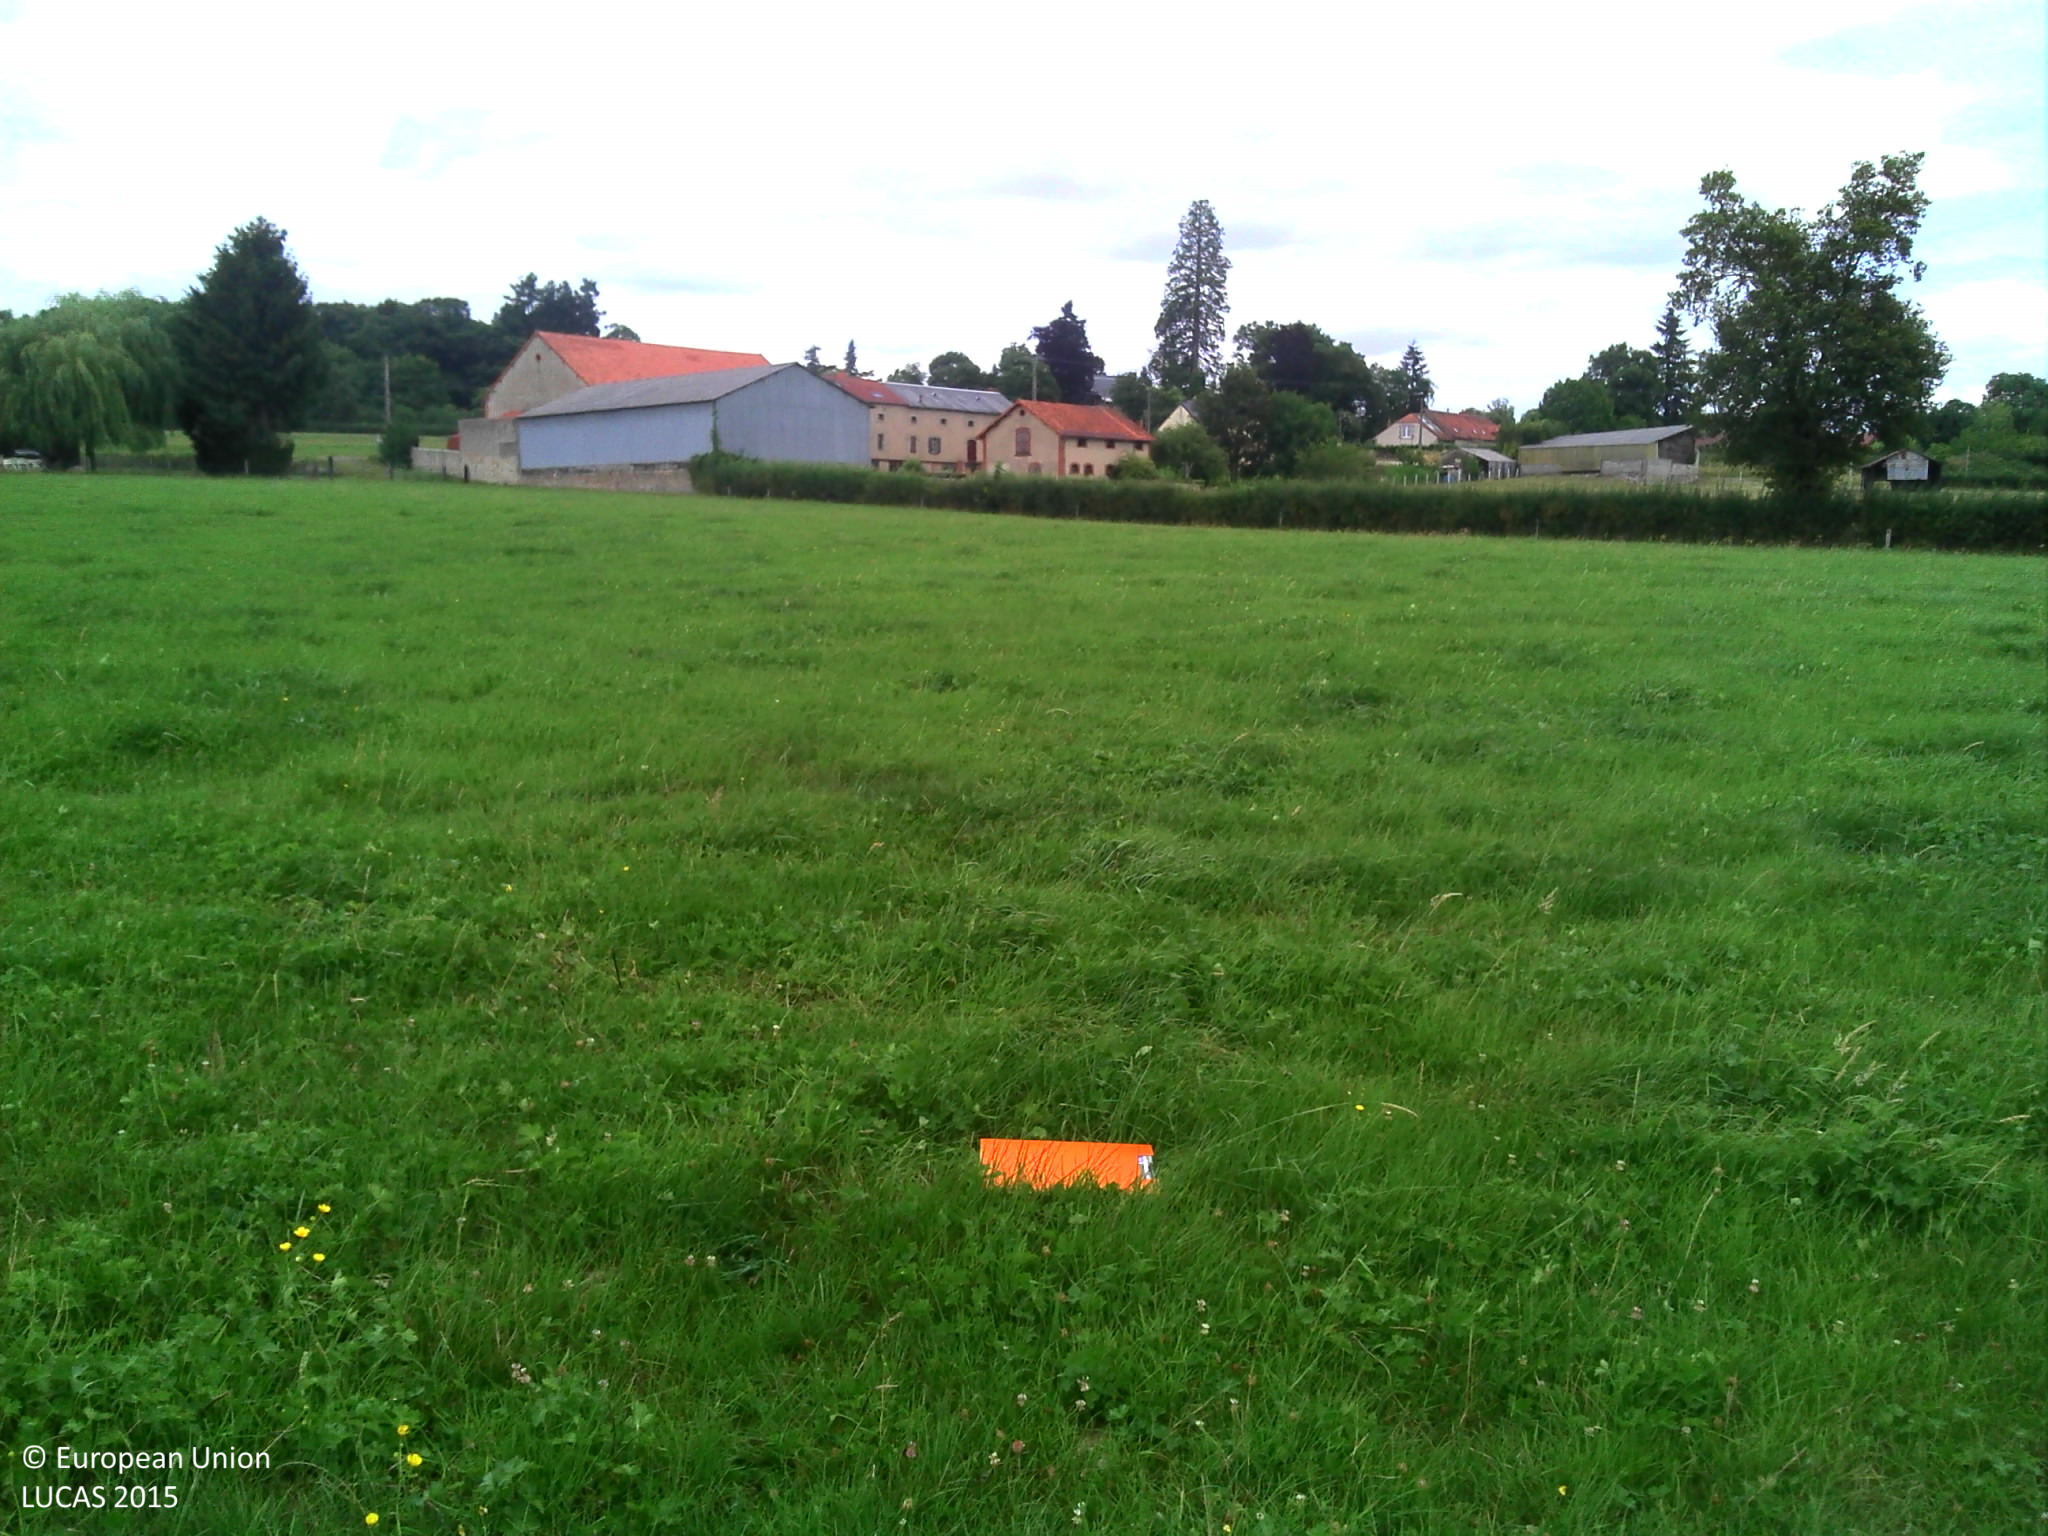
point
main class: Grassland
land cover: Grassland without tree/shrub cover
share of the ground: > 75 %
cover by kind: herbaceous plants 100 %
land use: Agriculture (excluding fallow land and kitchen gardens)
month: July
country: FR
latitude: 46.4151
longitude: 3.0633
